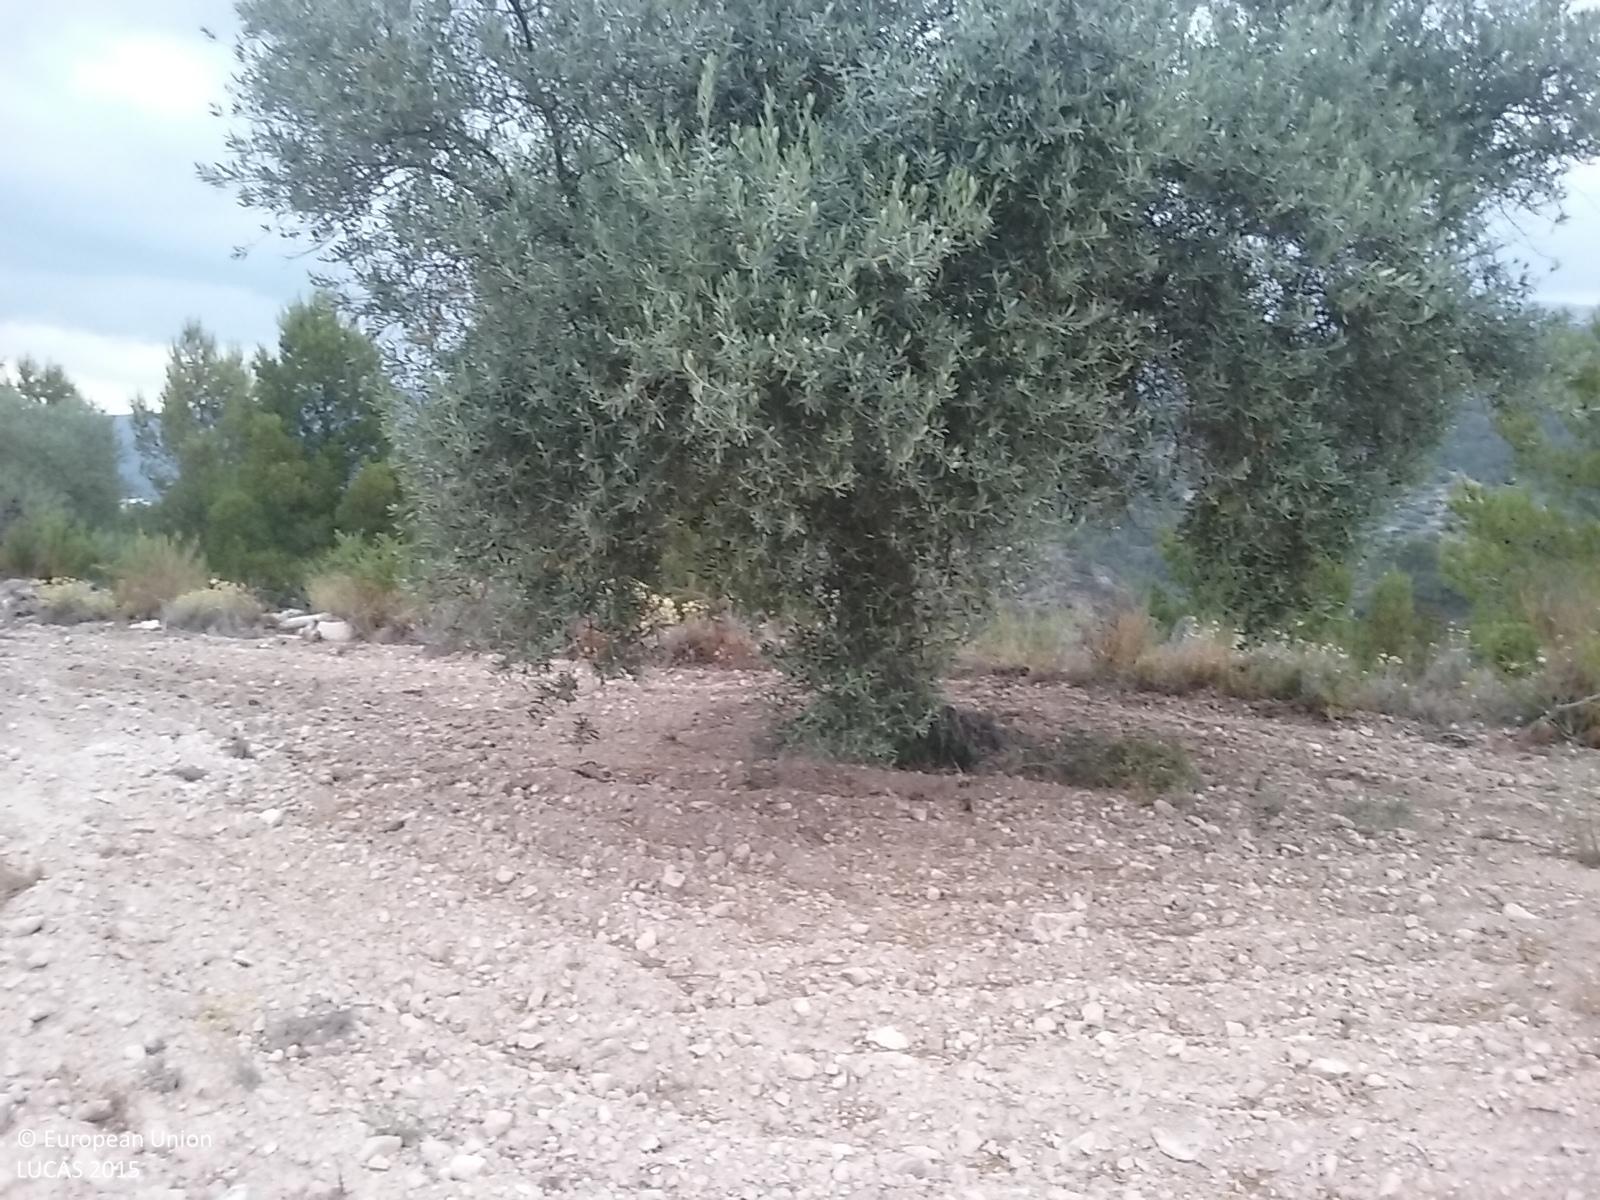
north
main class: Shrubland
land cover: Shrubland with sparse tree cover
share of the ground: 25 - 50 %
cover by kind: shrubs 50 %, unconsolidated bare surface 45 %, coniferous forest trees 5 %
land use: Semi-natural and natural areas not in use
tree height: < 5 m
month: June
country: ES
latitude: 40.8848
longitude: 0.5584
